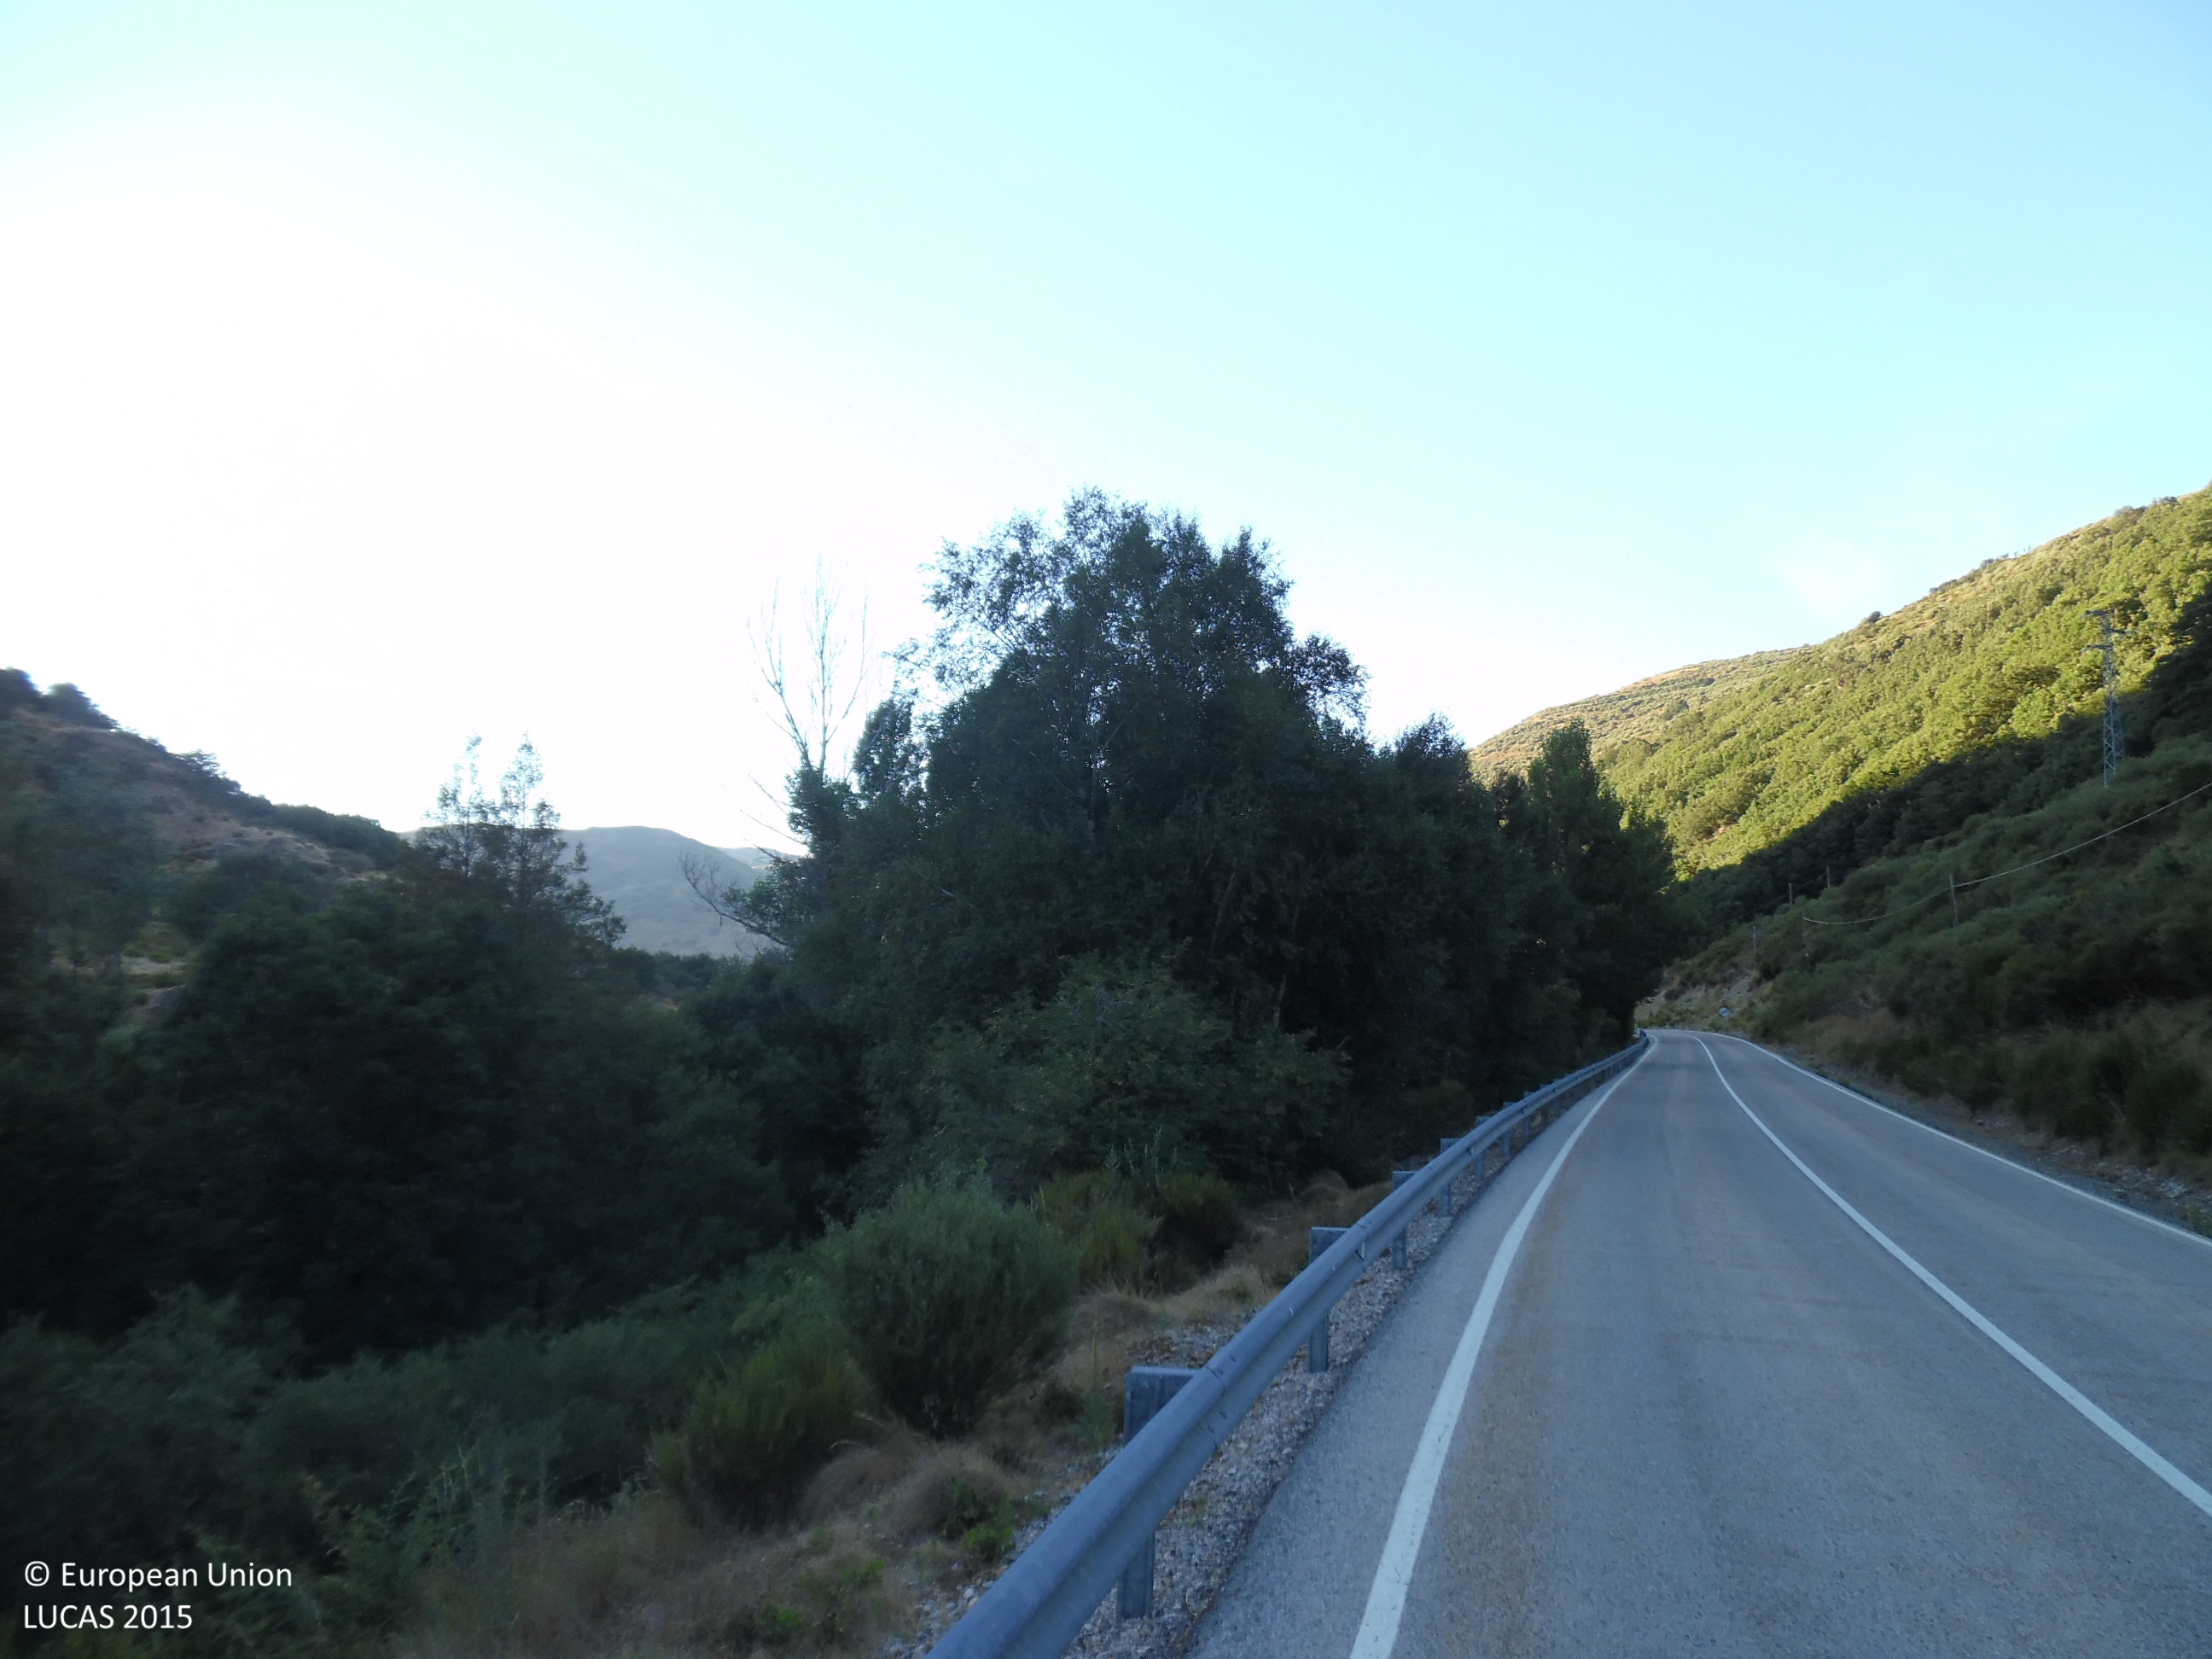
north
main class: Shrubland
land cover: Shrubland with sparse tree cover
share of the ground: > 75 %
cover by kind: shrubs 95 %, broadleaved forest trees 5 %
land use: Agriculture (excluding fallow land and kitchen gardens)
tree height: > 5 m
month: July
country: ES
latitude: 42.8362
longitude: -6.1520
